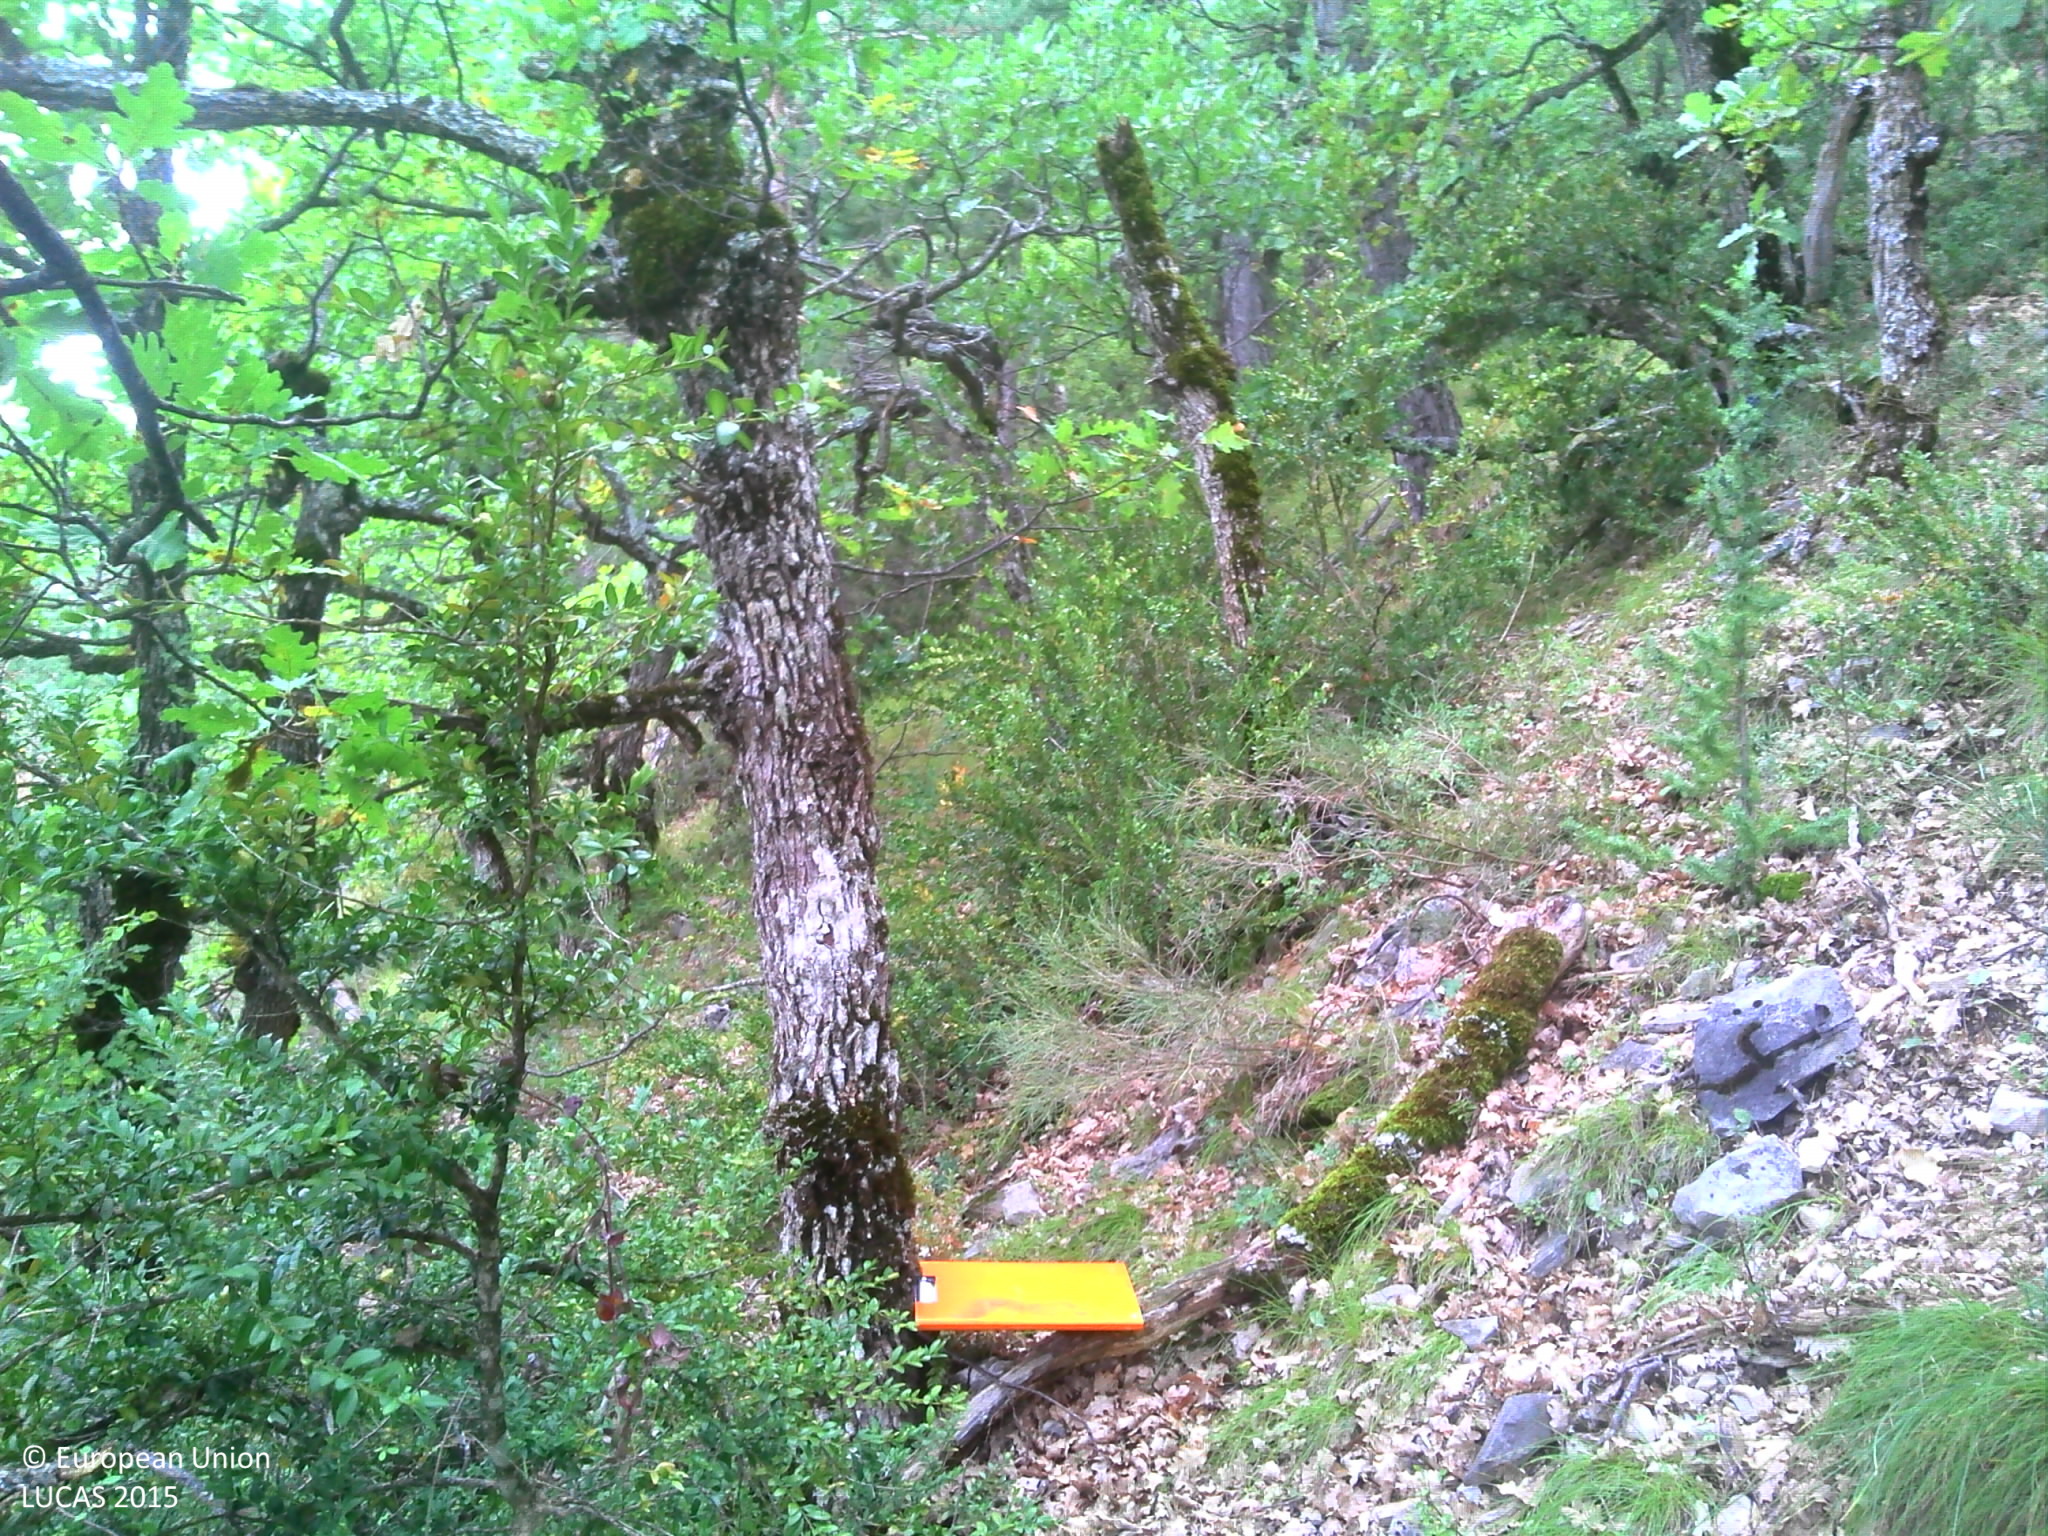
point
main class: Woodland
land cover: Pine dominated mixed woodland
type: coniferous forest of the mediterranean region
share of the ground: > 75 %
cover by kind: broadleaved forest trees 75 %, coniferous forest trees 25 %
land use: Forestry
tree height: > 5 m
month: September
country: FR
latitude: 44.5965
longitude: 5.5094
